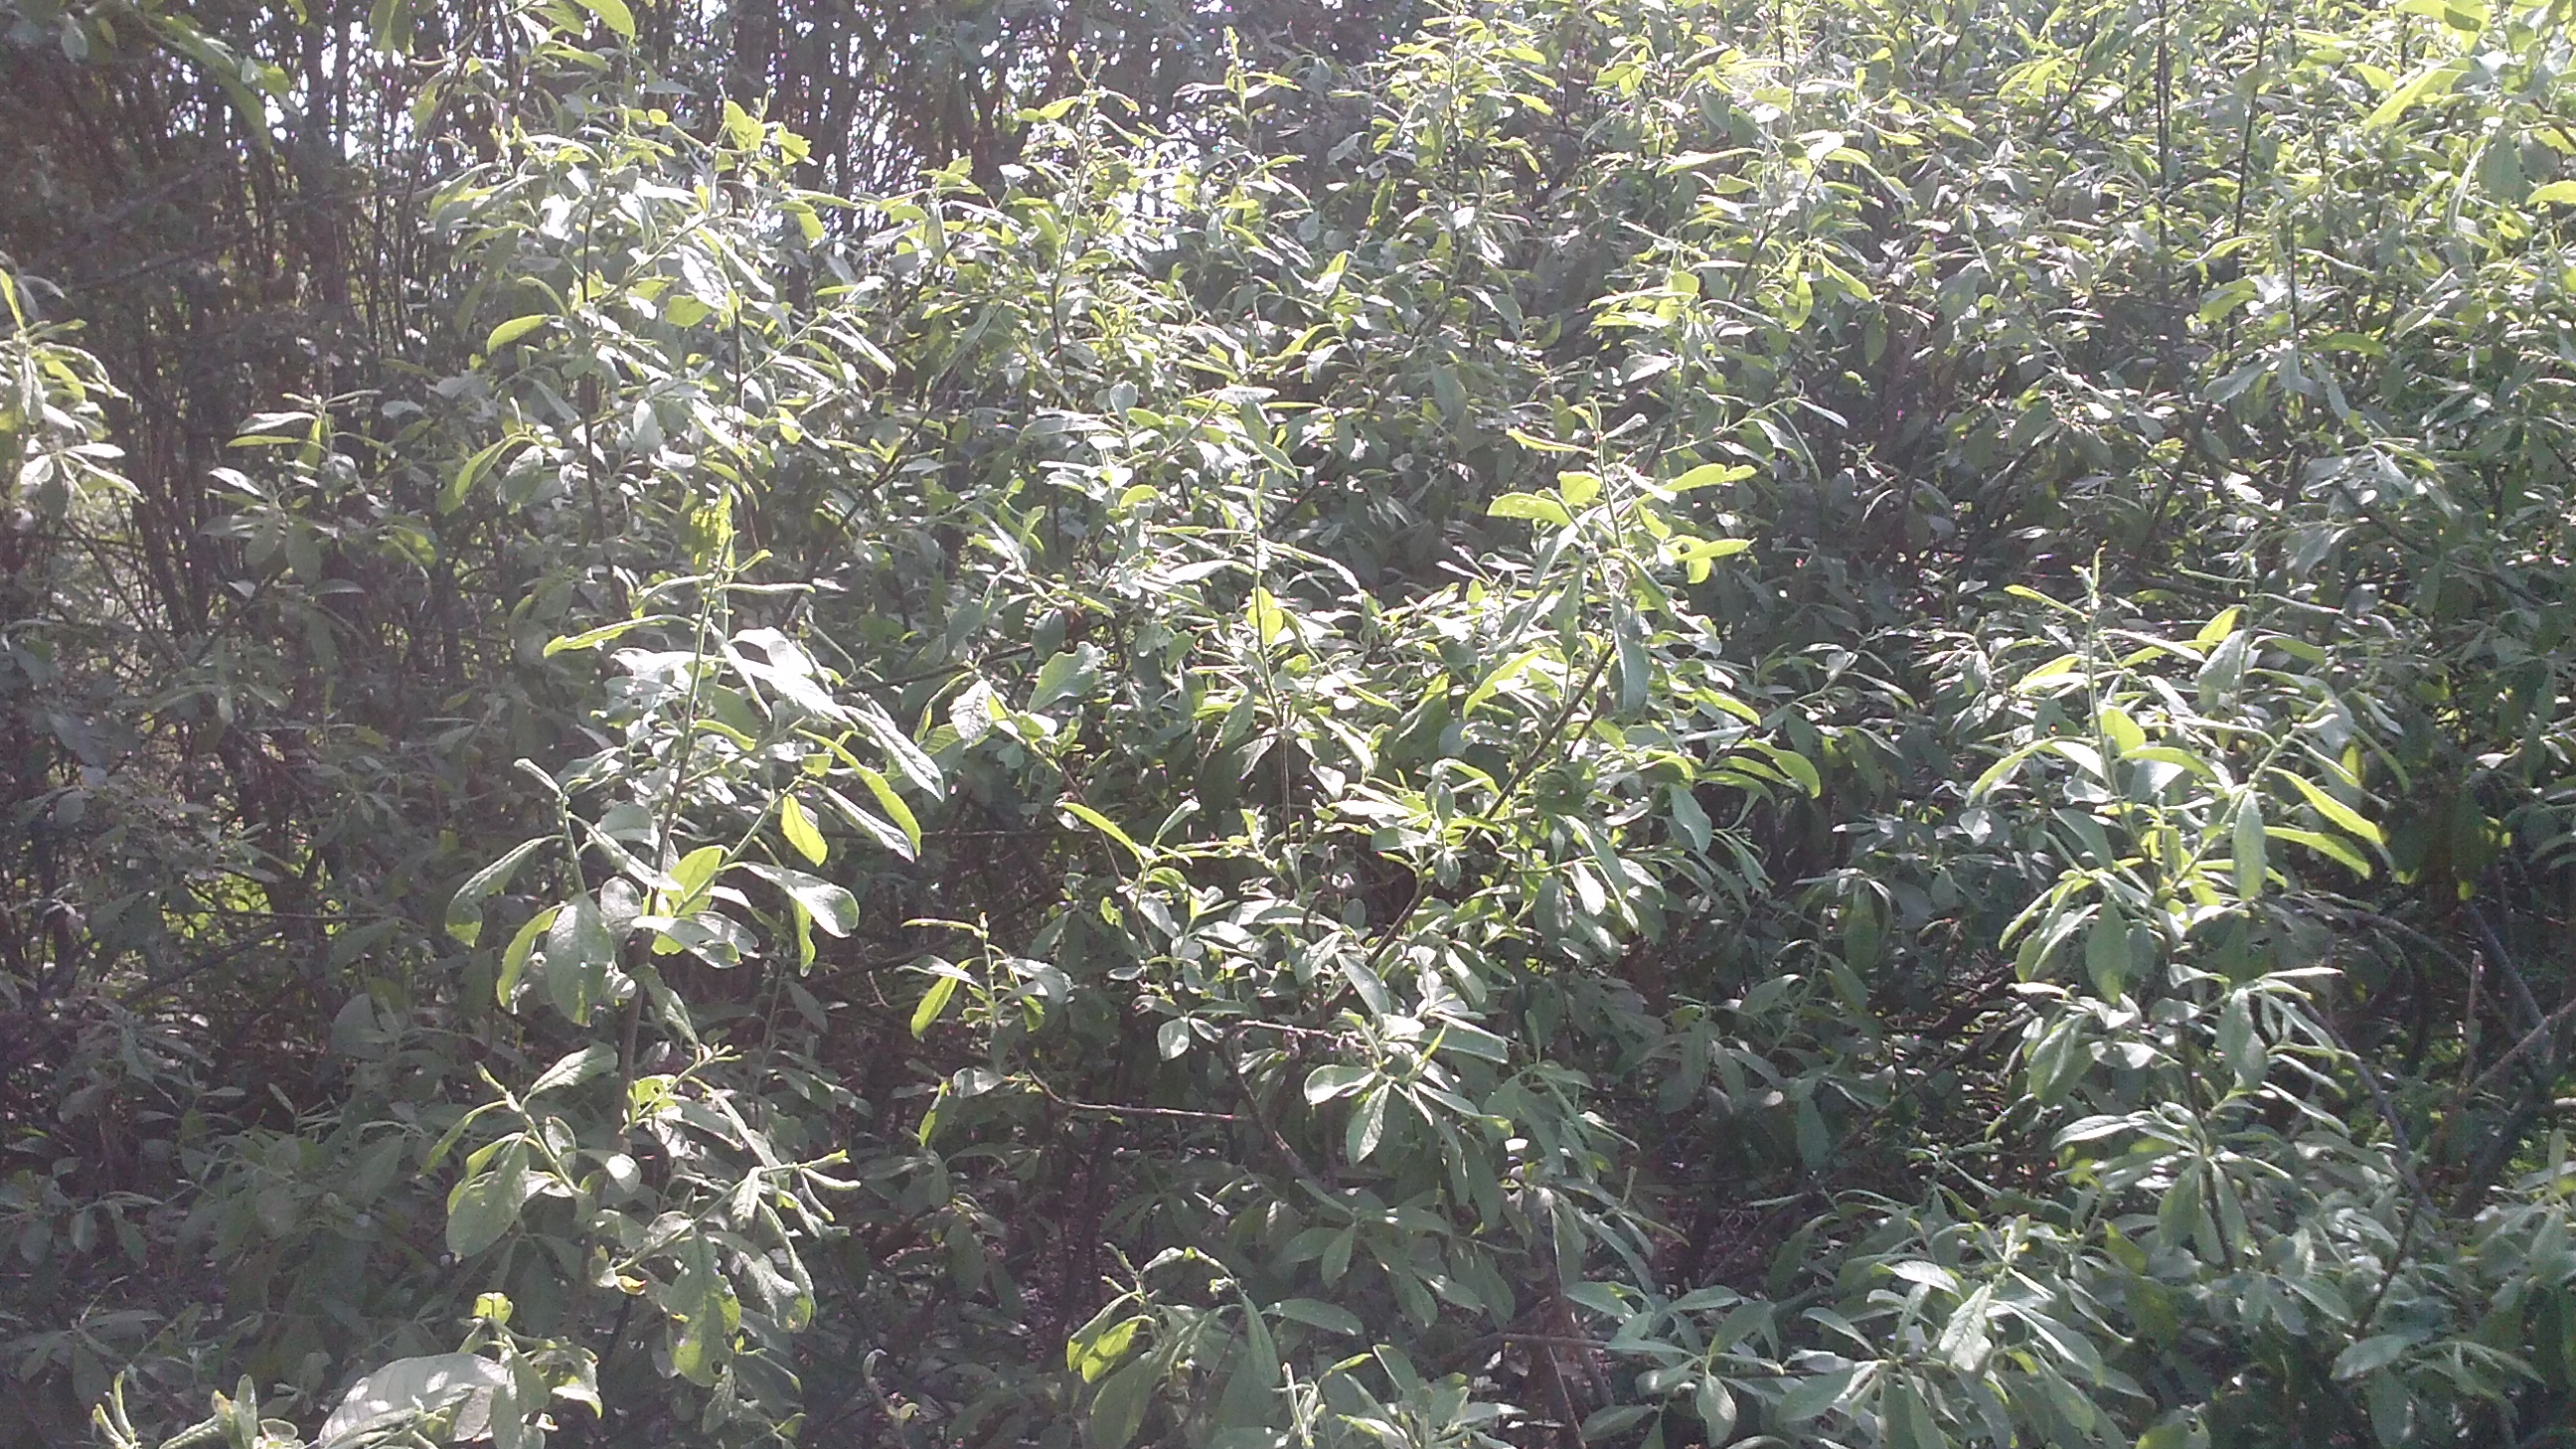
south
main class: Shrubland
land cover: Shrubland without tree cover
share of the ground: > 75 %
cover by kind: shrubs 90 %, herbaceous plants 10 %
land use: Semi-natural and natural areas not in use
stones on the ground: < 10 %
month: June
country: LV
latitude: 56.2345
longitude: 28.0922
